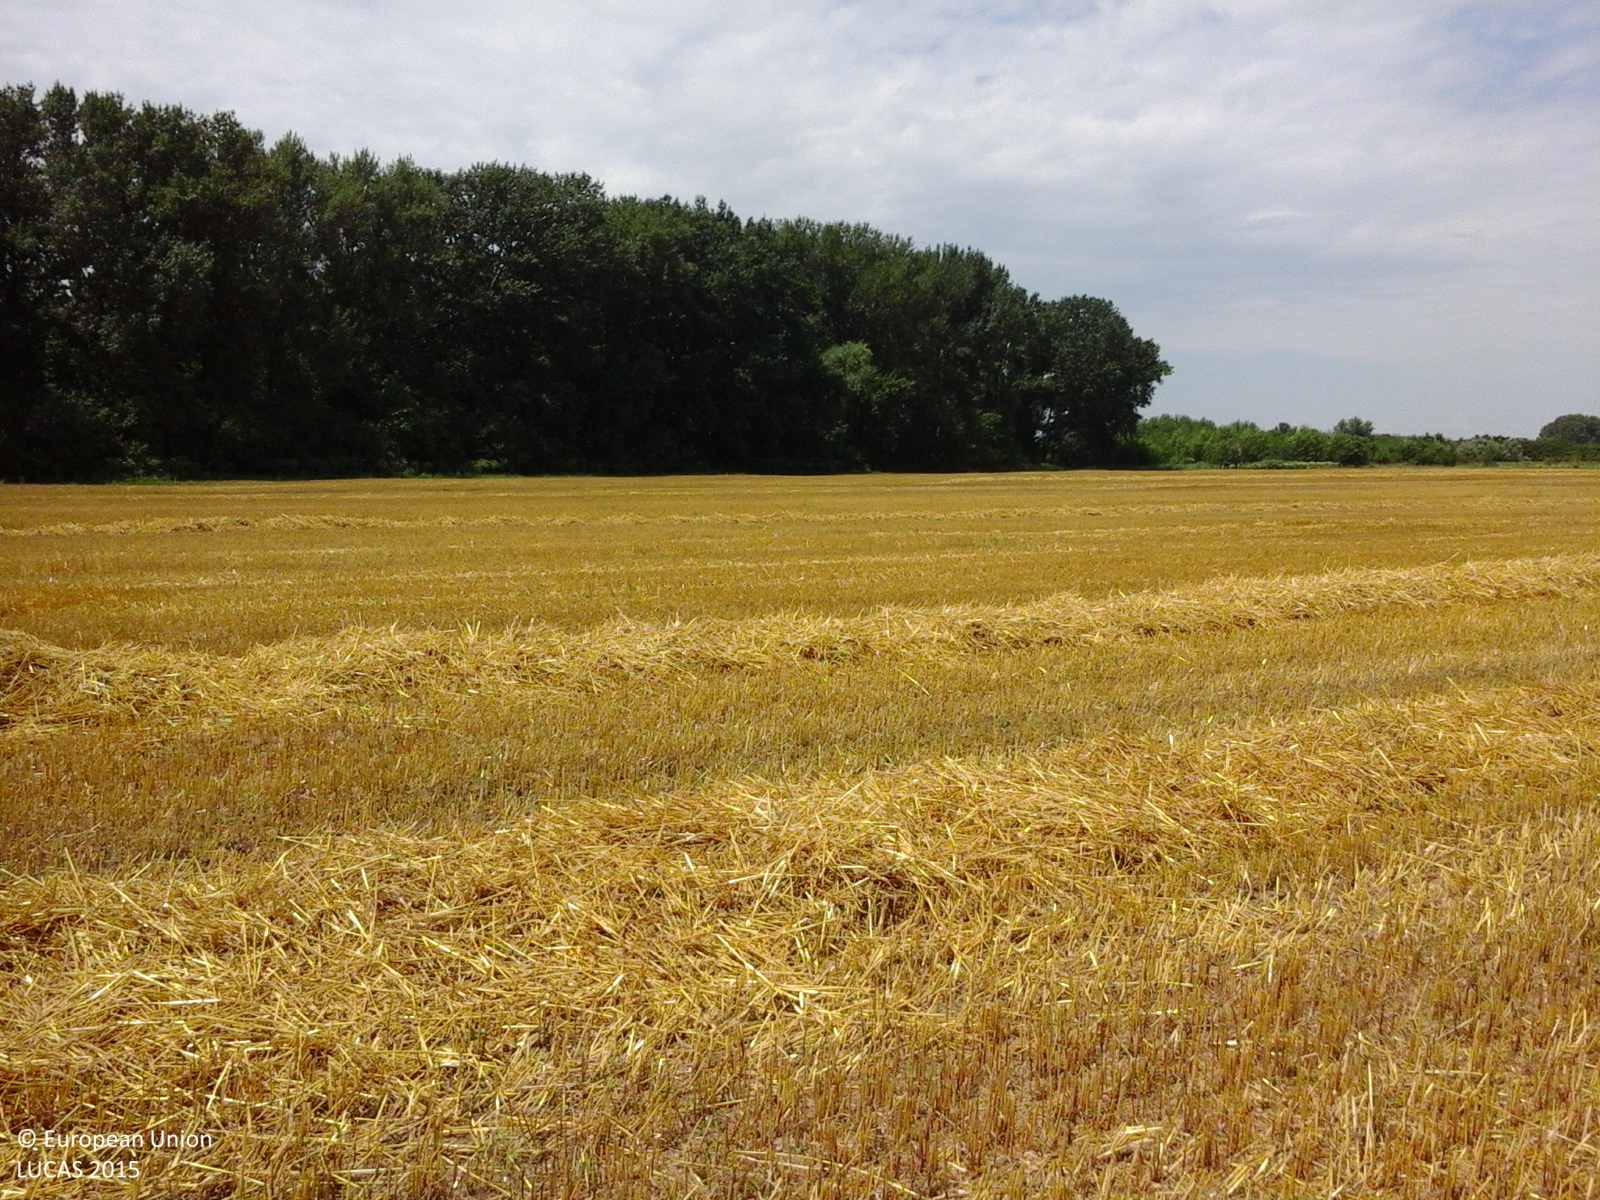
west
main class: Cropland
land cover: Barley
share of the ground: > 75 %
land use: Agriculture (excluding fallow land and kitchen gardens)
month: June
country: RO
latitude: 44.3675
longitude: 25.8726
